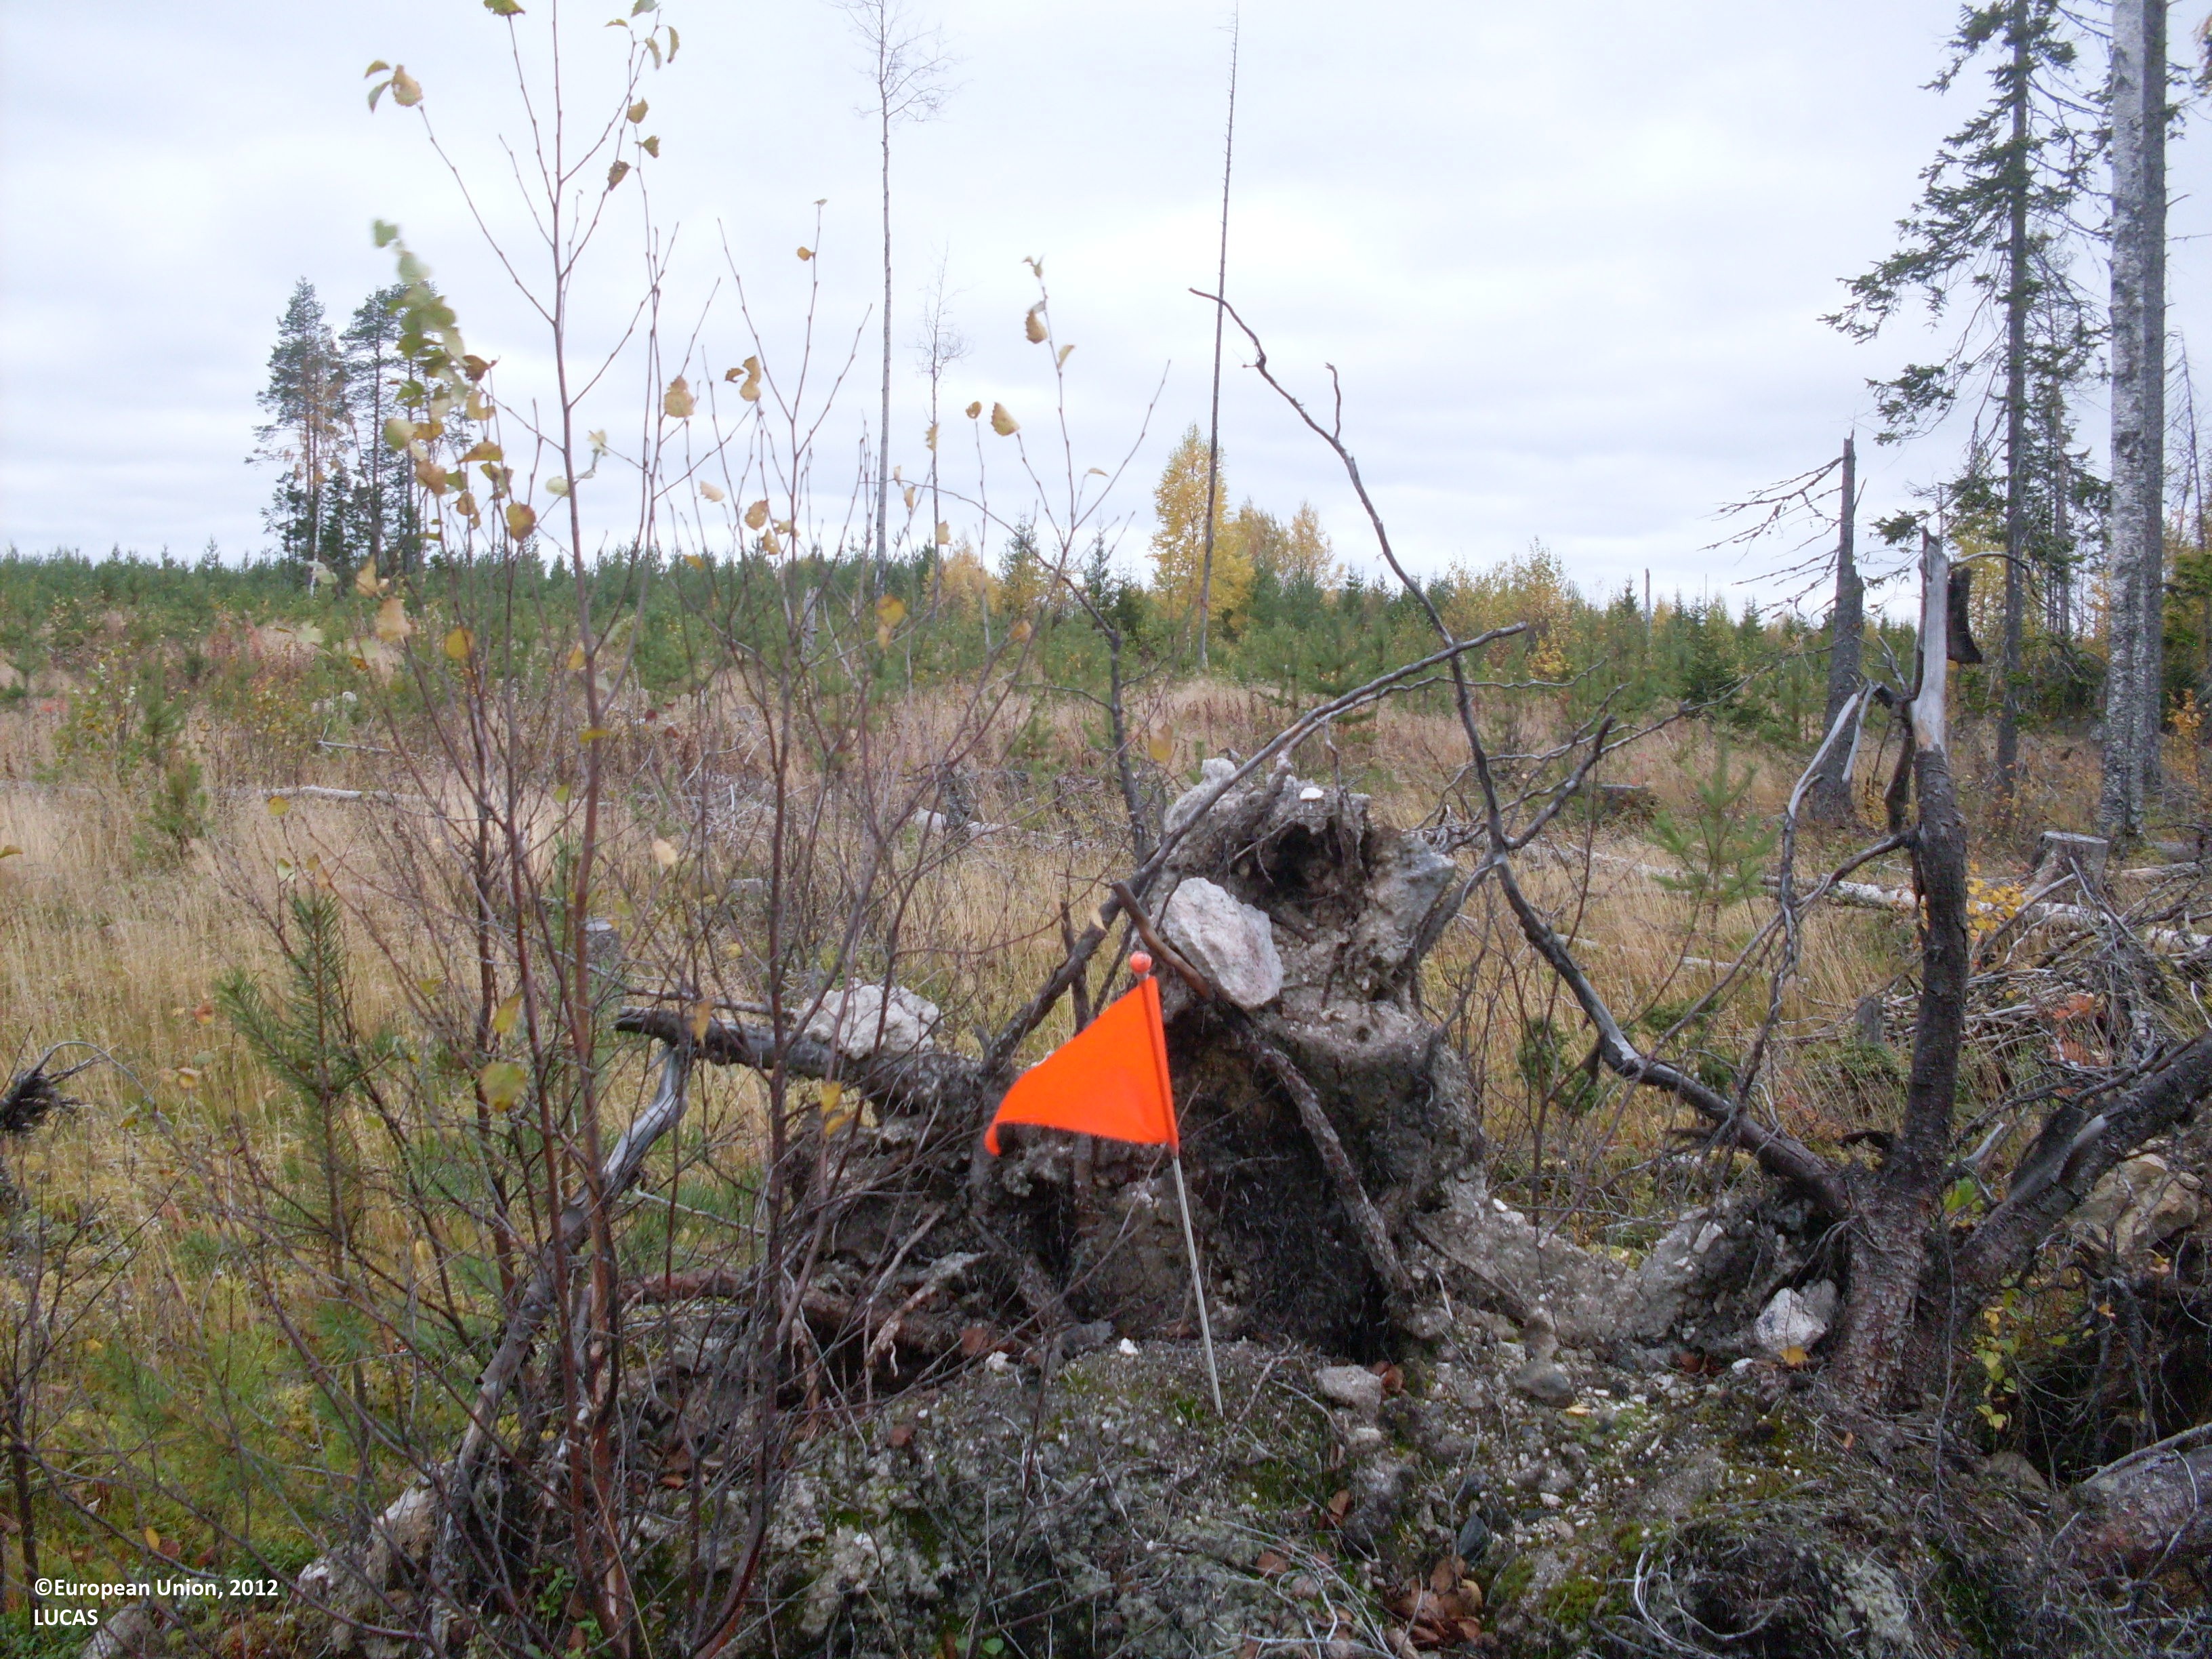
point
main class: Shrubland
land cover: Shrubland with sparse tree cover
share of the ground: 50 - 75 %
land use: Forestry
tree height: > 5 m
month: September
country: FI
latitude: 64.4147
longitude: 30.0141
